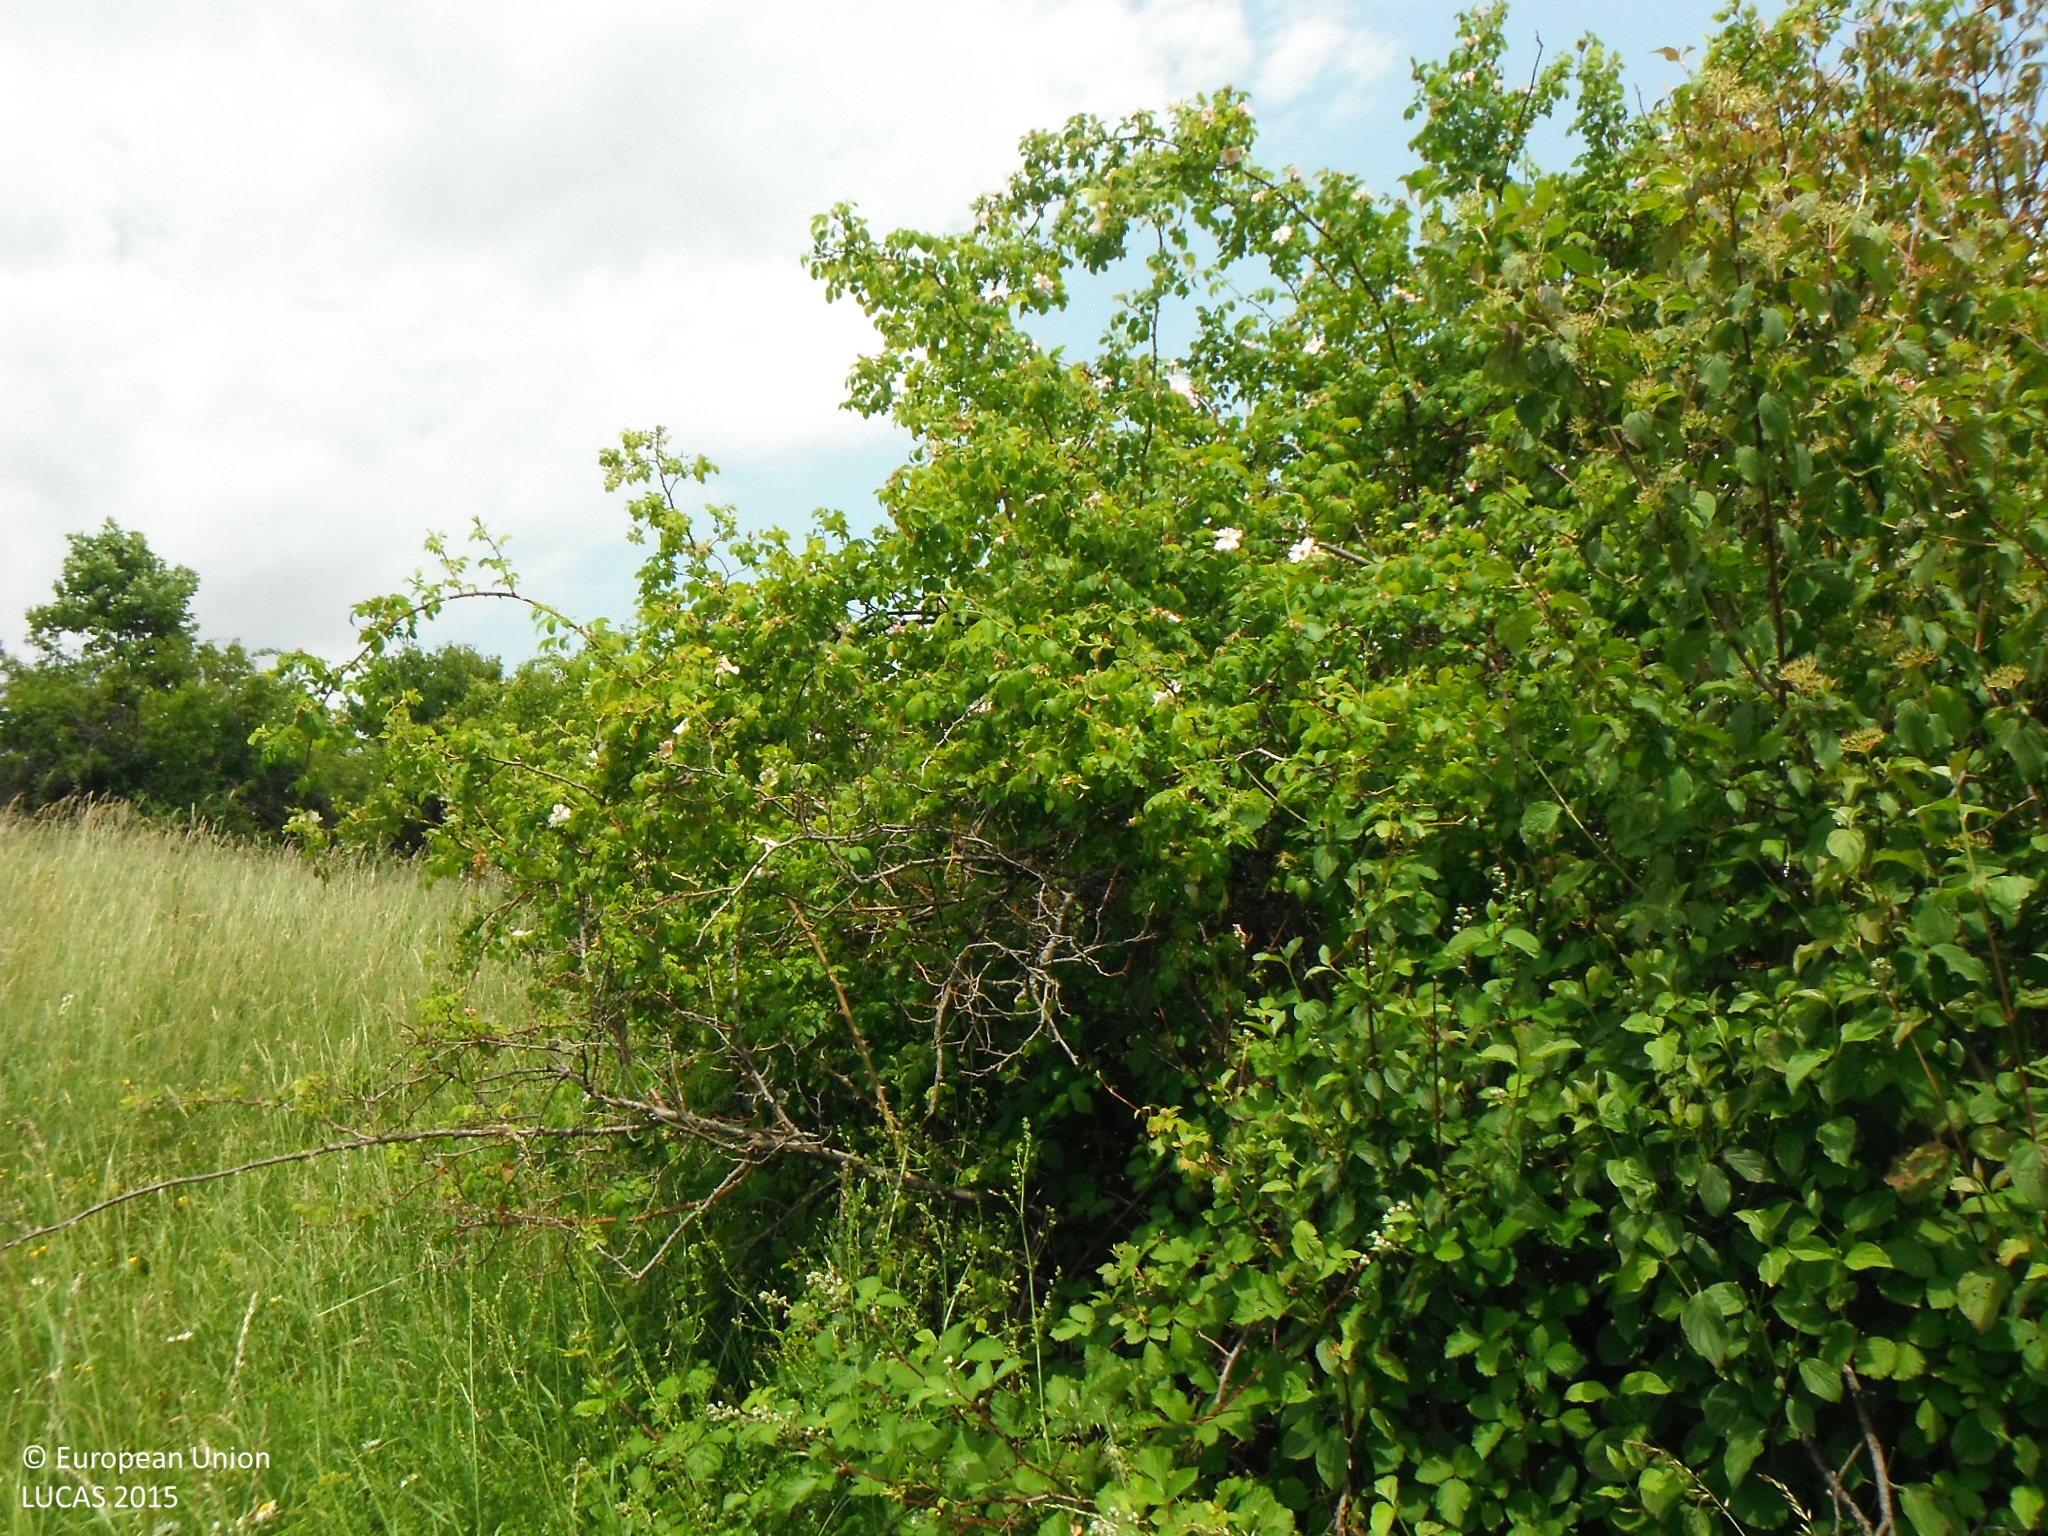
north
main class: Shrubland
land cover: Shrubland without tree cover
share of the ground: 50 - 75 %
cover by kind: shrubs 60 %, herbaceous plants 40 %
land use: Abandoned areas
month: June
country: SK
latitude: 49.1918
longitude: 21.2285
